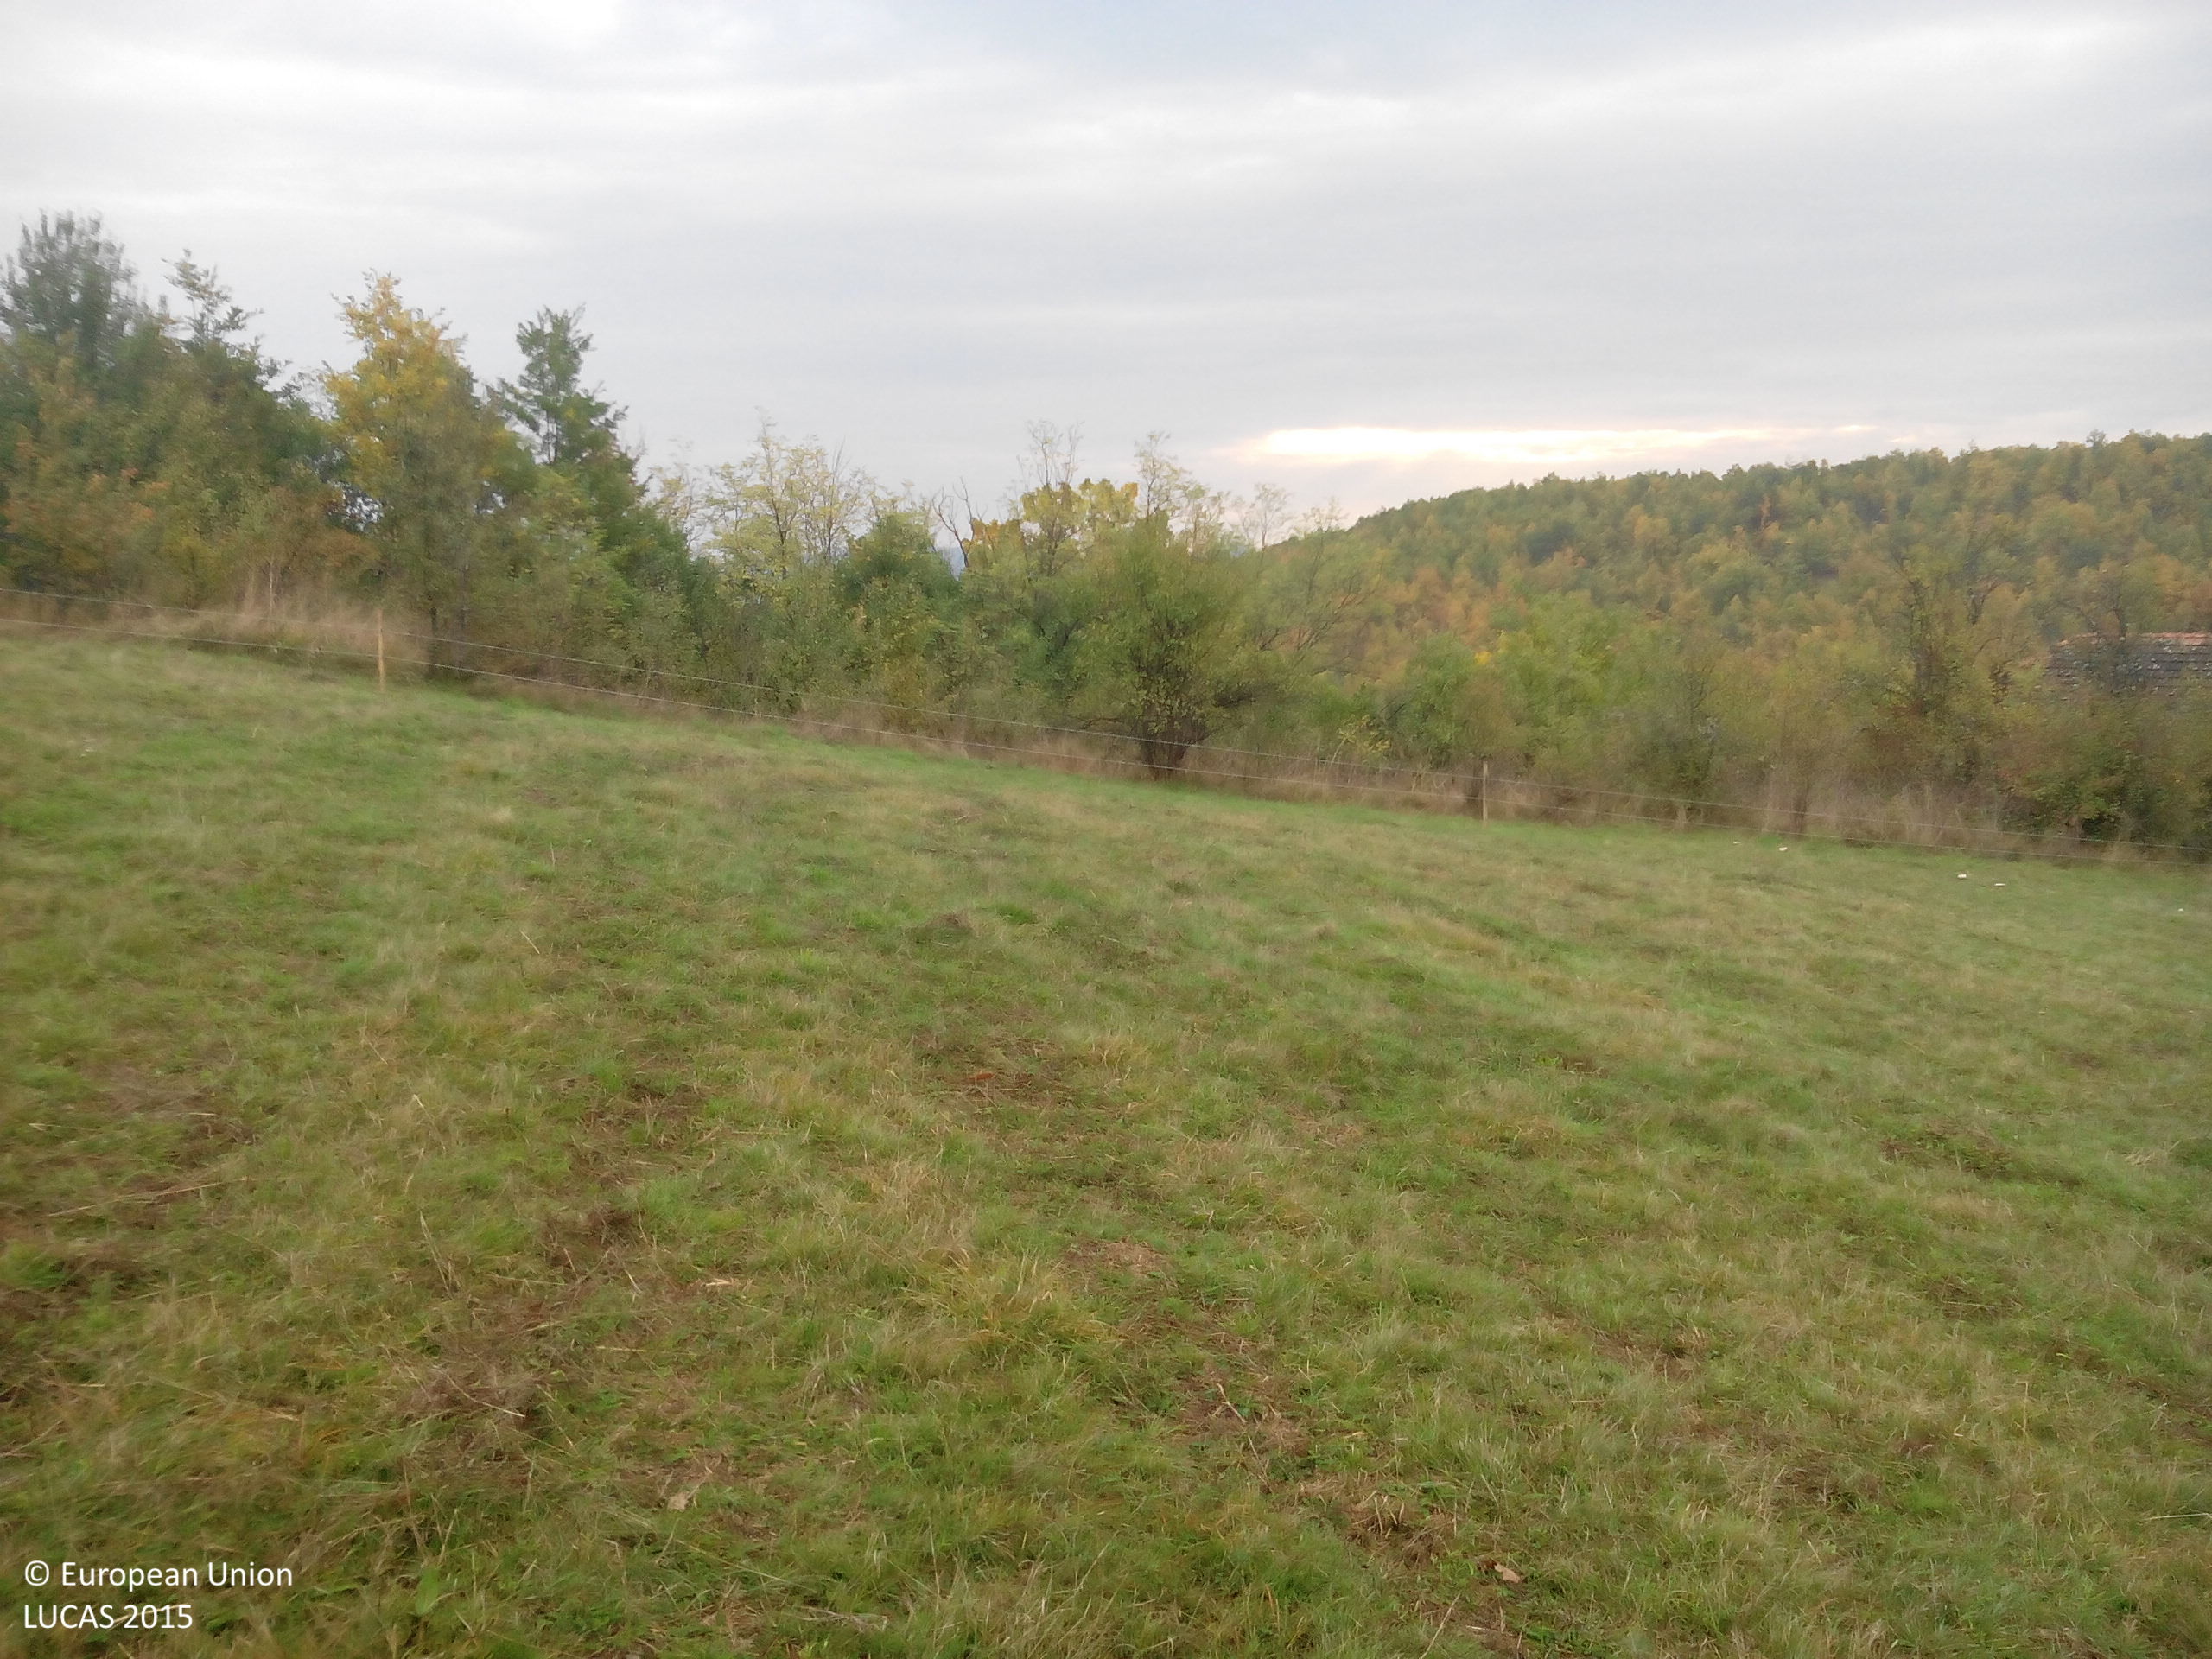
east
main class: Grassland
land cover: Grassland without tree/shrub cover
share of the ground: > 75 %
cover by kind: herbaceous plants 100 %
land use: Agriculture (excluding fallow land and kitchen gardens)
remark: Harvested field
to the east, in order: Grassland without tree/shrub cover; Fences; Grassland without tree/shrub cover; Broadleaved woodland; Tracks; Broadleaved woodland
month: October
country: BG
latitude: 42.9237
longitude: 23.9767
